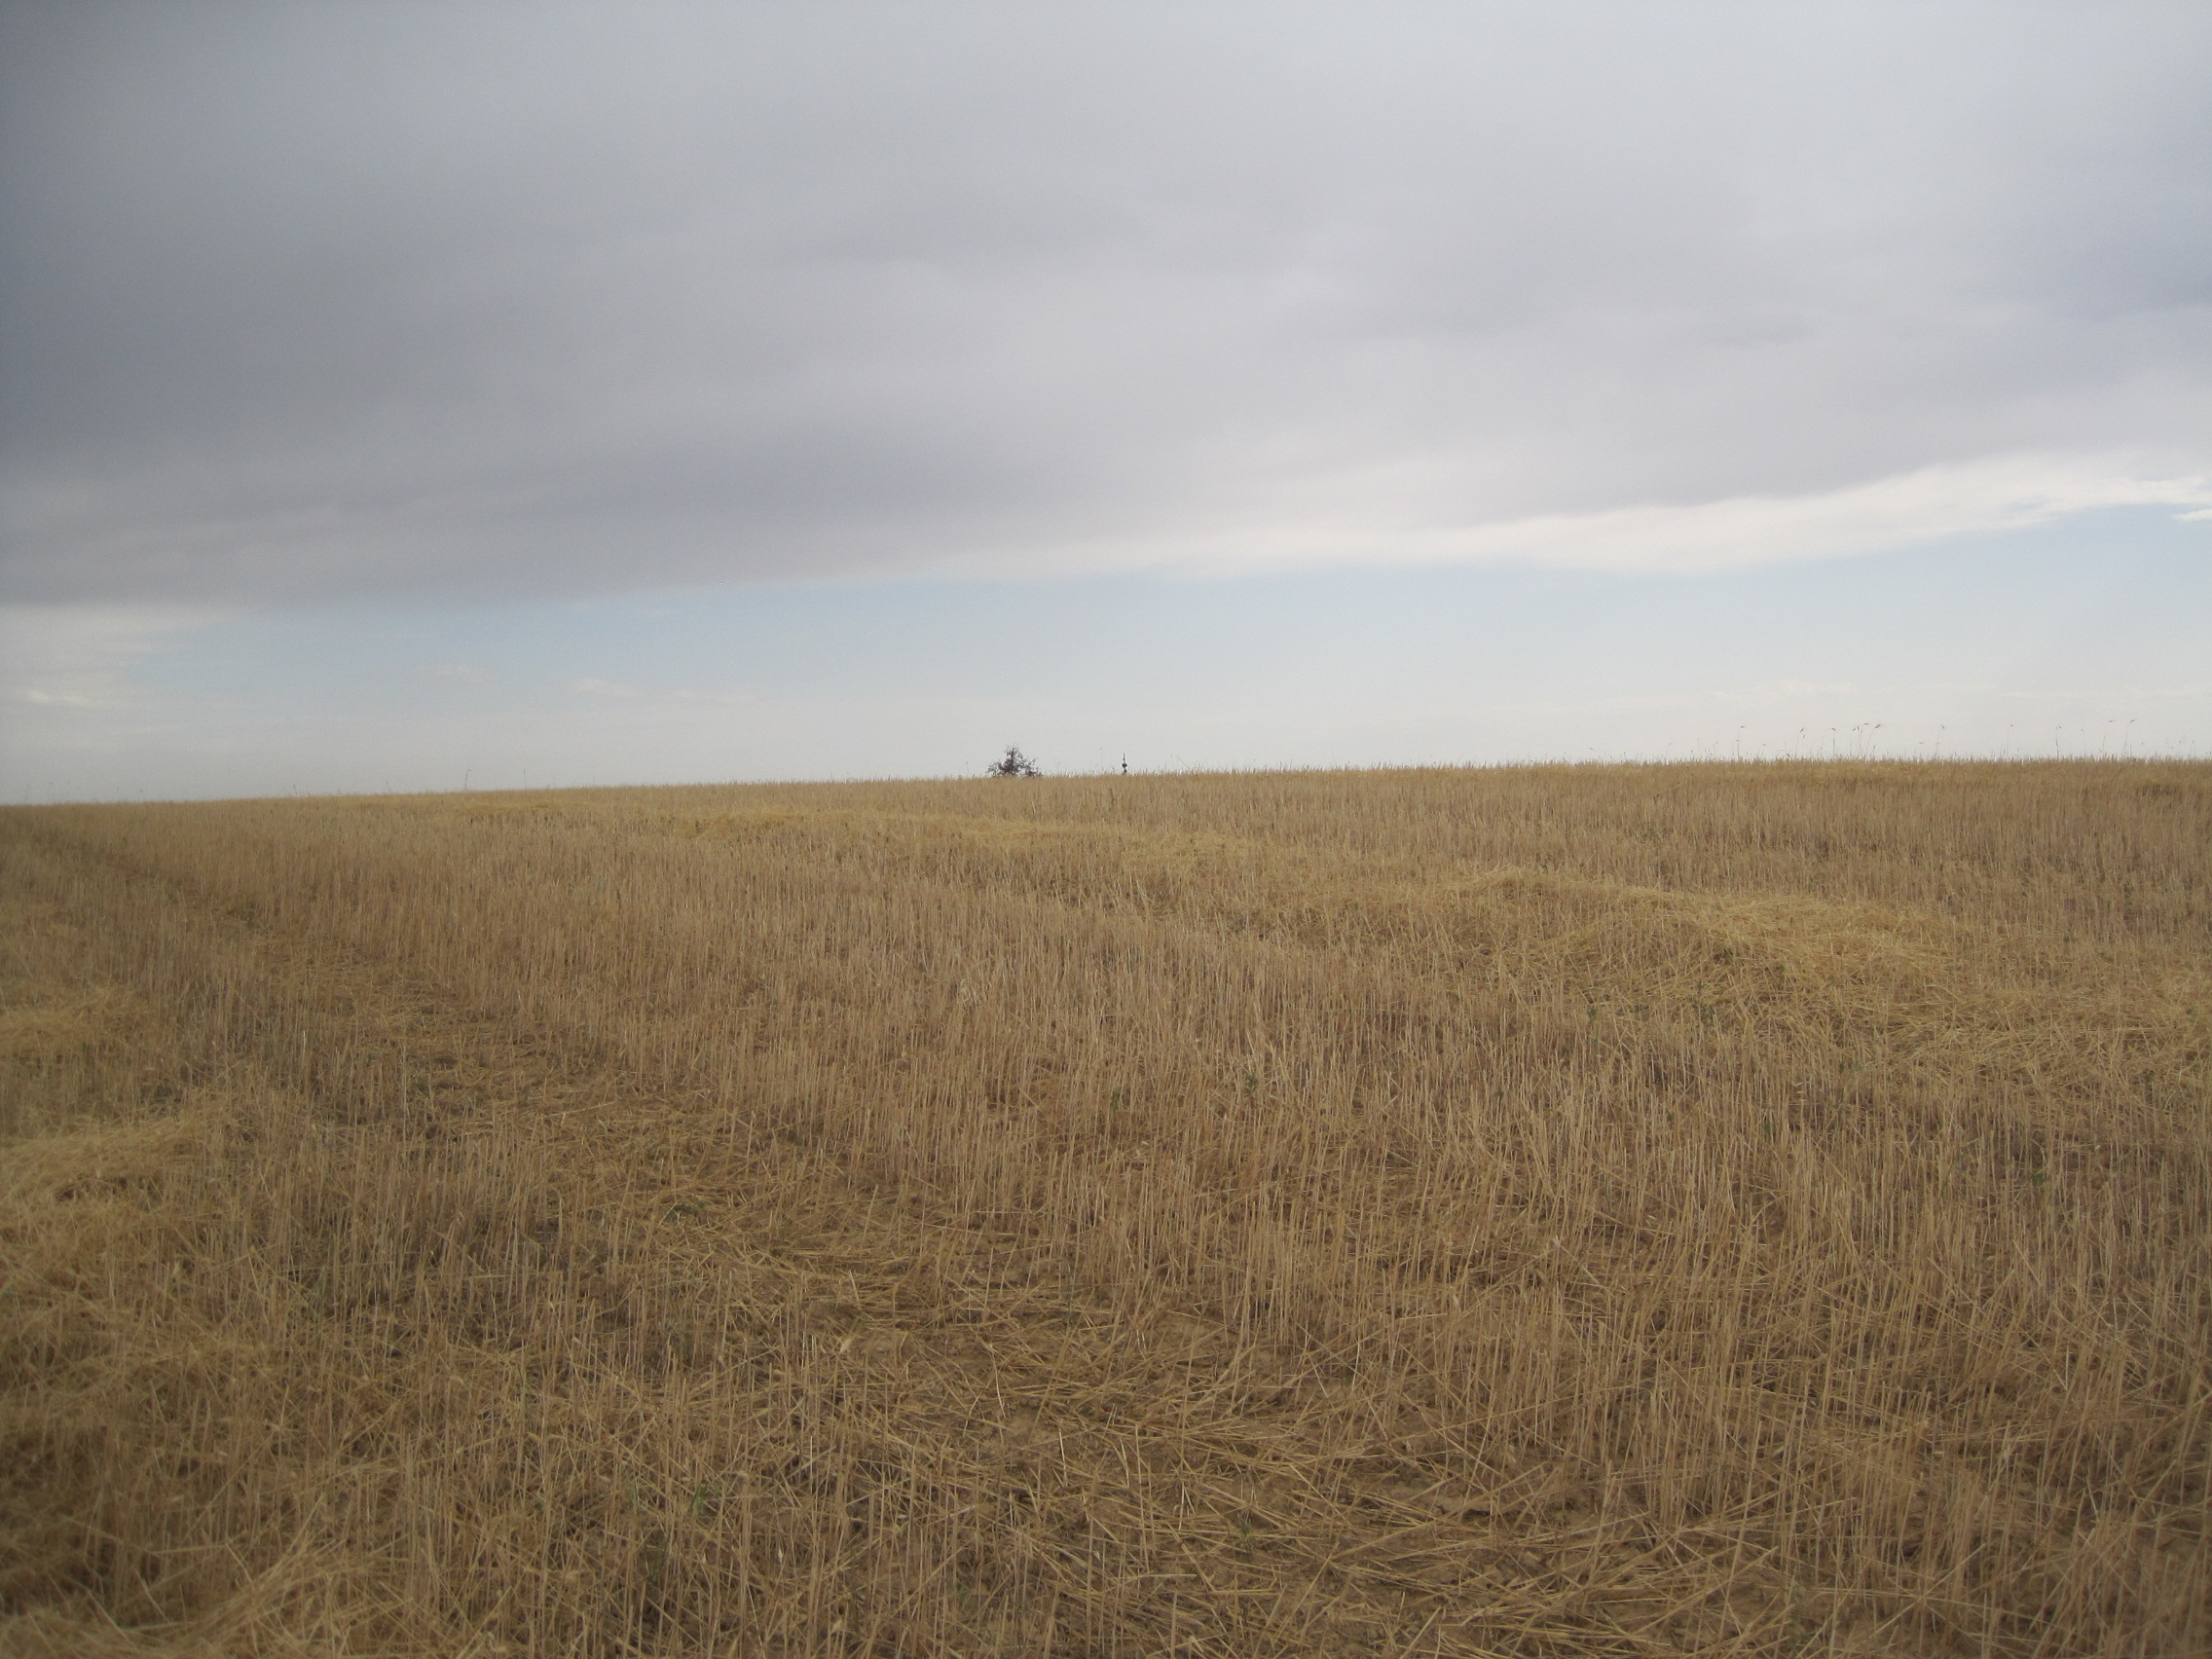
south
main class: Cropland
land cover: Rye
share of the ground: < 10 %
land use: Agriculture (excluding fallow land and kitchen gardens)
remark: Harvested field
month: July
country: ES
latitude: 41.8249
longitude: -5.5828
